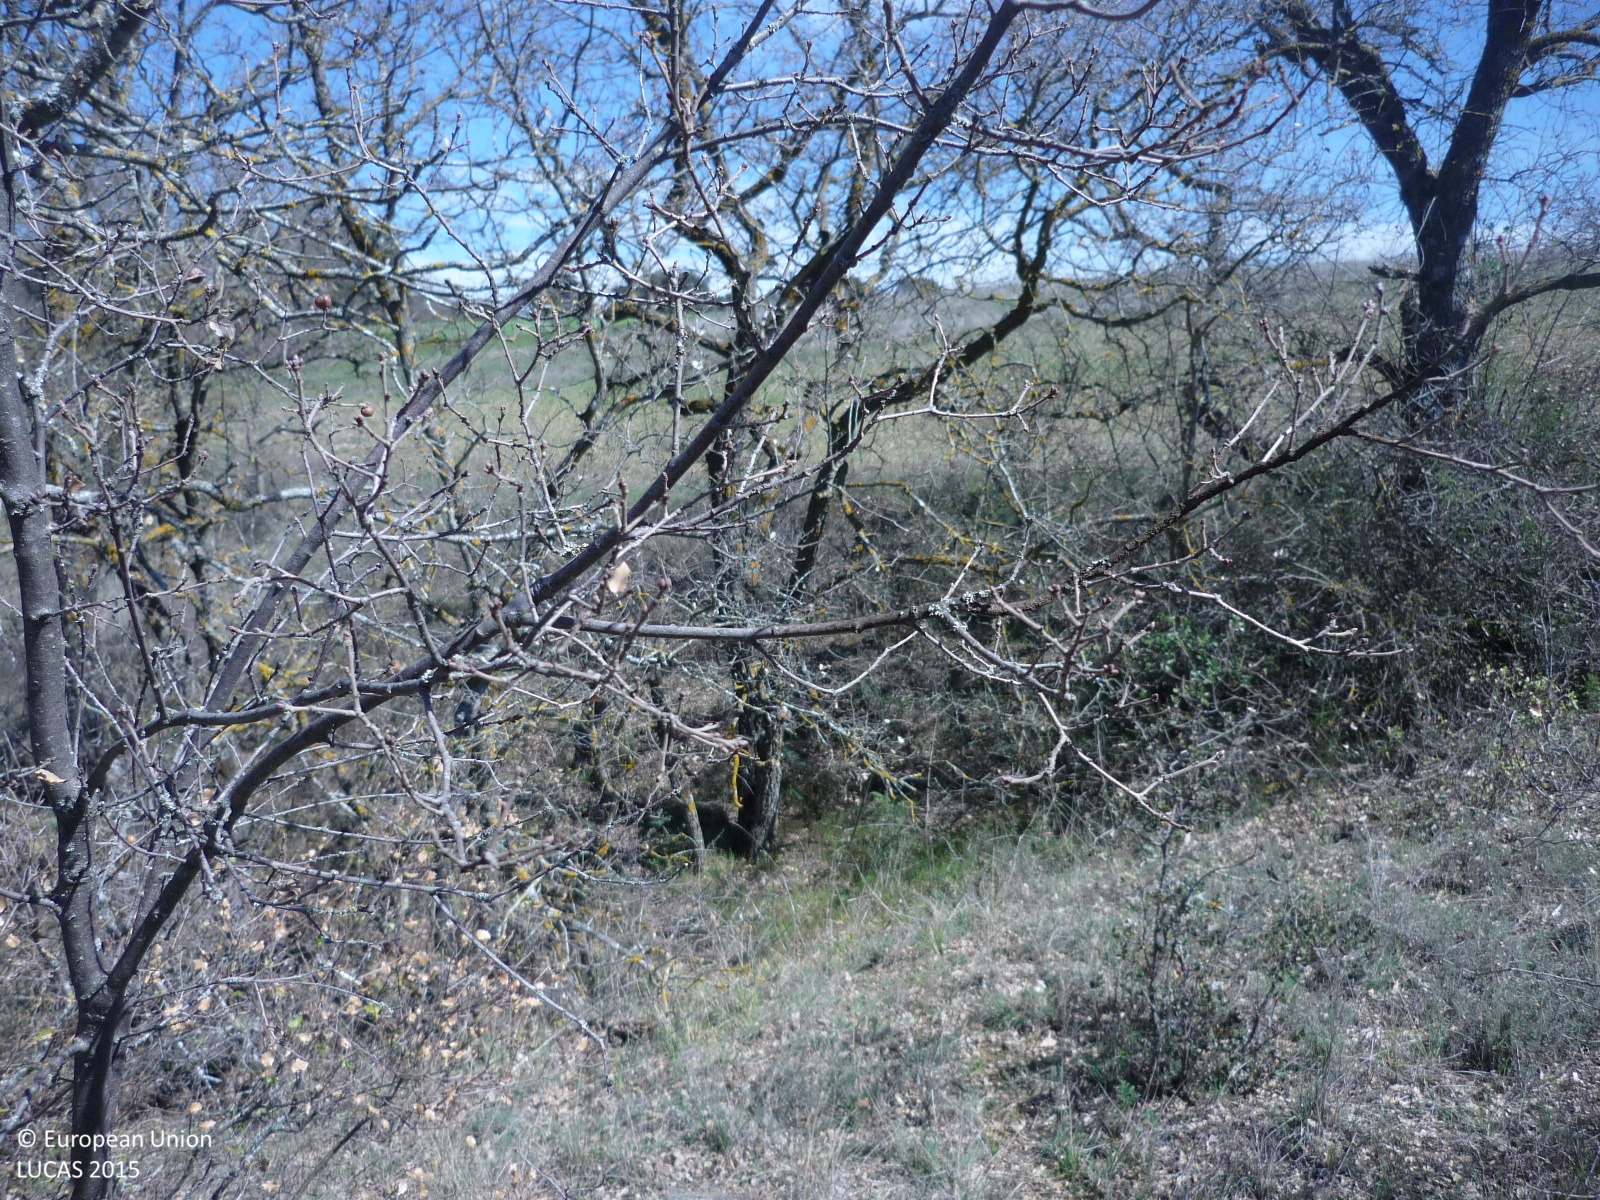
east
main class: Woodland
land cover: Broadleaved woodland
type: thermophilous deciduous forest
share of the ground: 50 - 75 %
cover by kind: broadleaved forest trees 50 %, herbaceous plants 25 %, unconsolidated bare surface 25 %
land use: Semi-natural and natural areas not in use
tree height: < 5 m
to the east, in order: Broadleaved woodland; Barley; Dry pulses; Shrubland with sparse tree cover
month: March
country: ES
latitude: 40.3911
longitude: -3.2375
